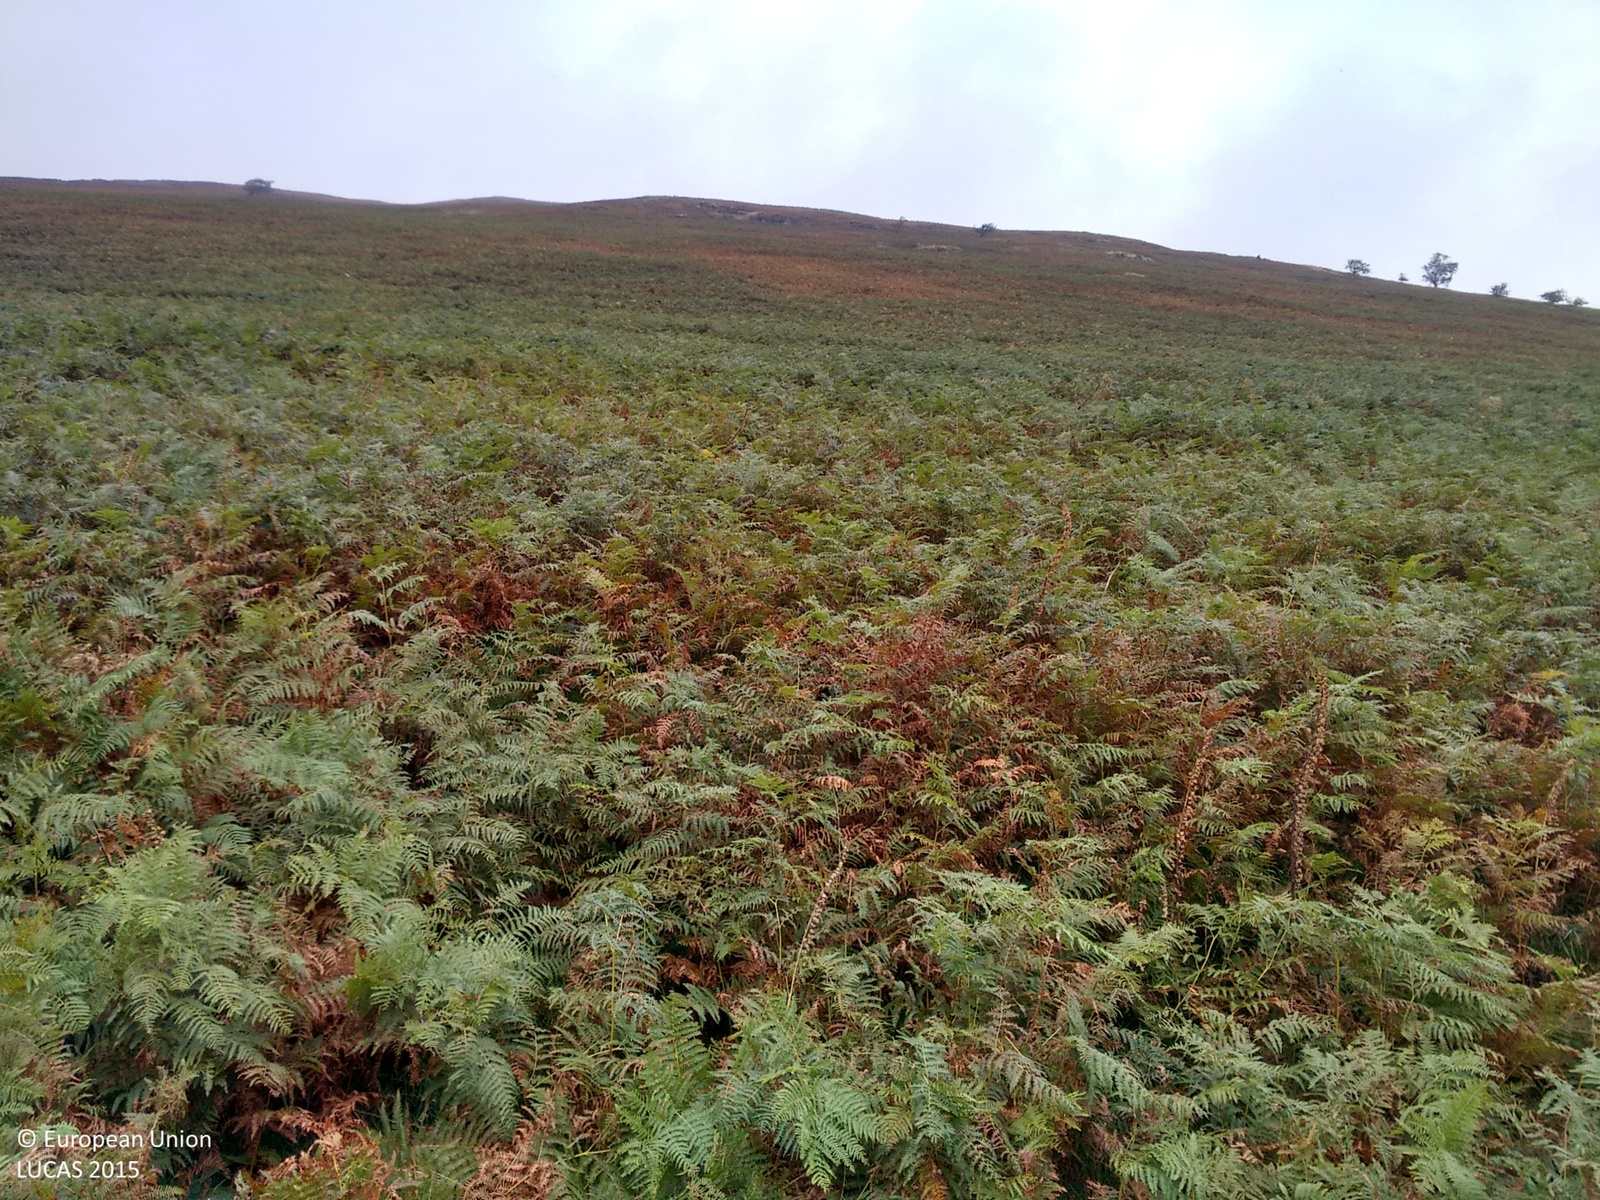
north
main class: Shrubland
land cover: Shrubland without tree cover
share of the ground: > 75 %
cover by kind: shrubs 100 %
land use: Agriculture (excluding fallow land and kitchen gardens)
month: October
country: GB
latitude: 54.5882
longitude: -3.2143
